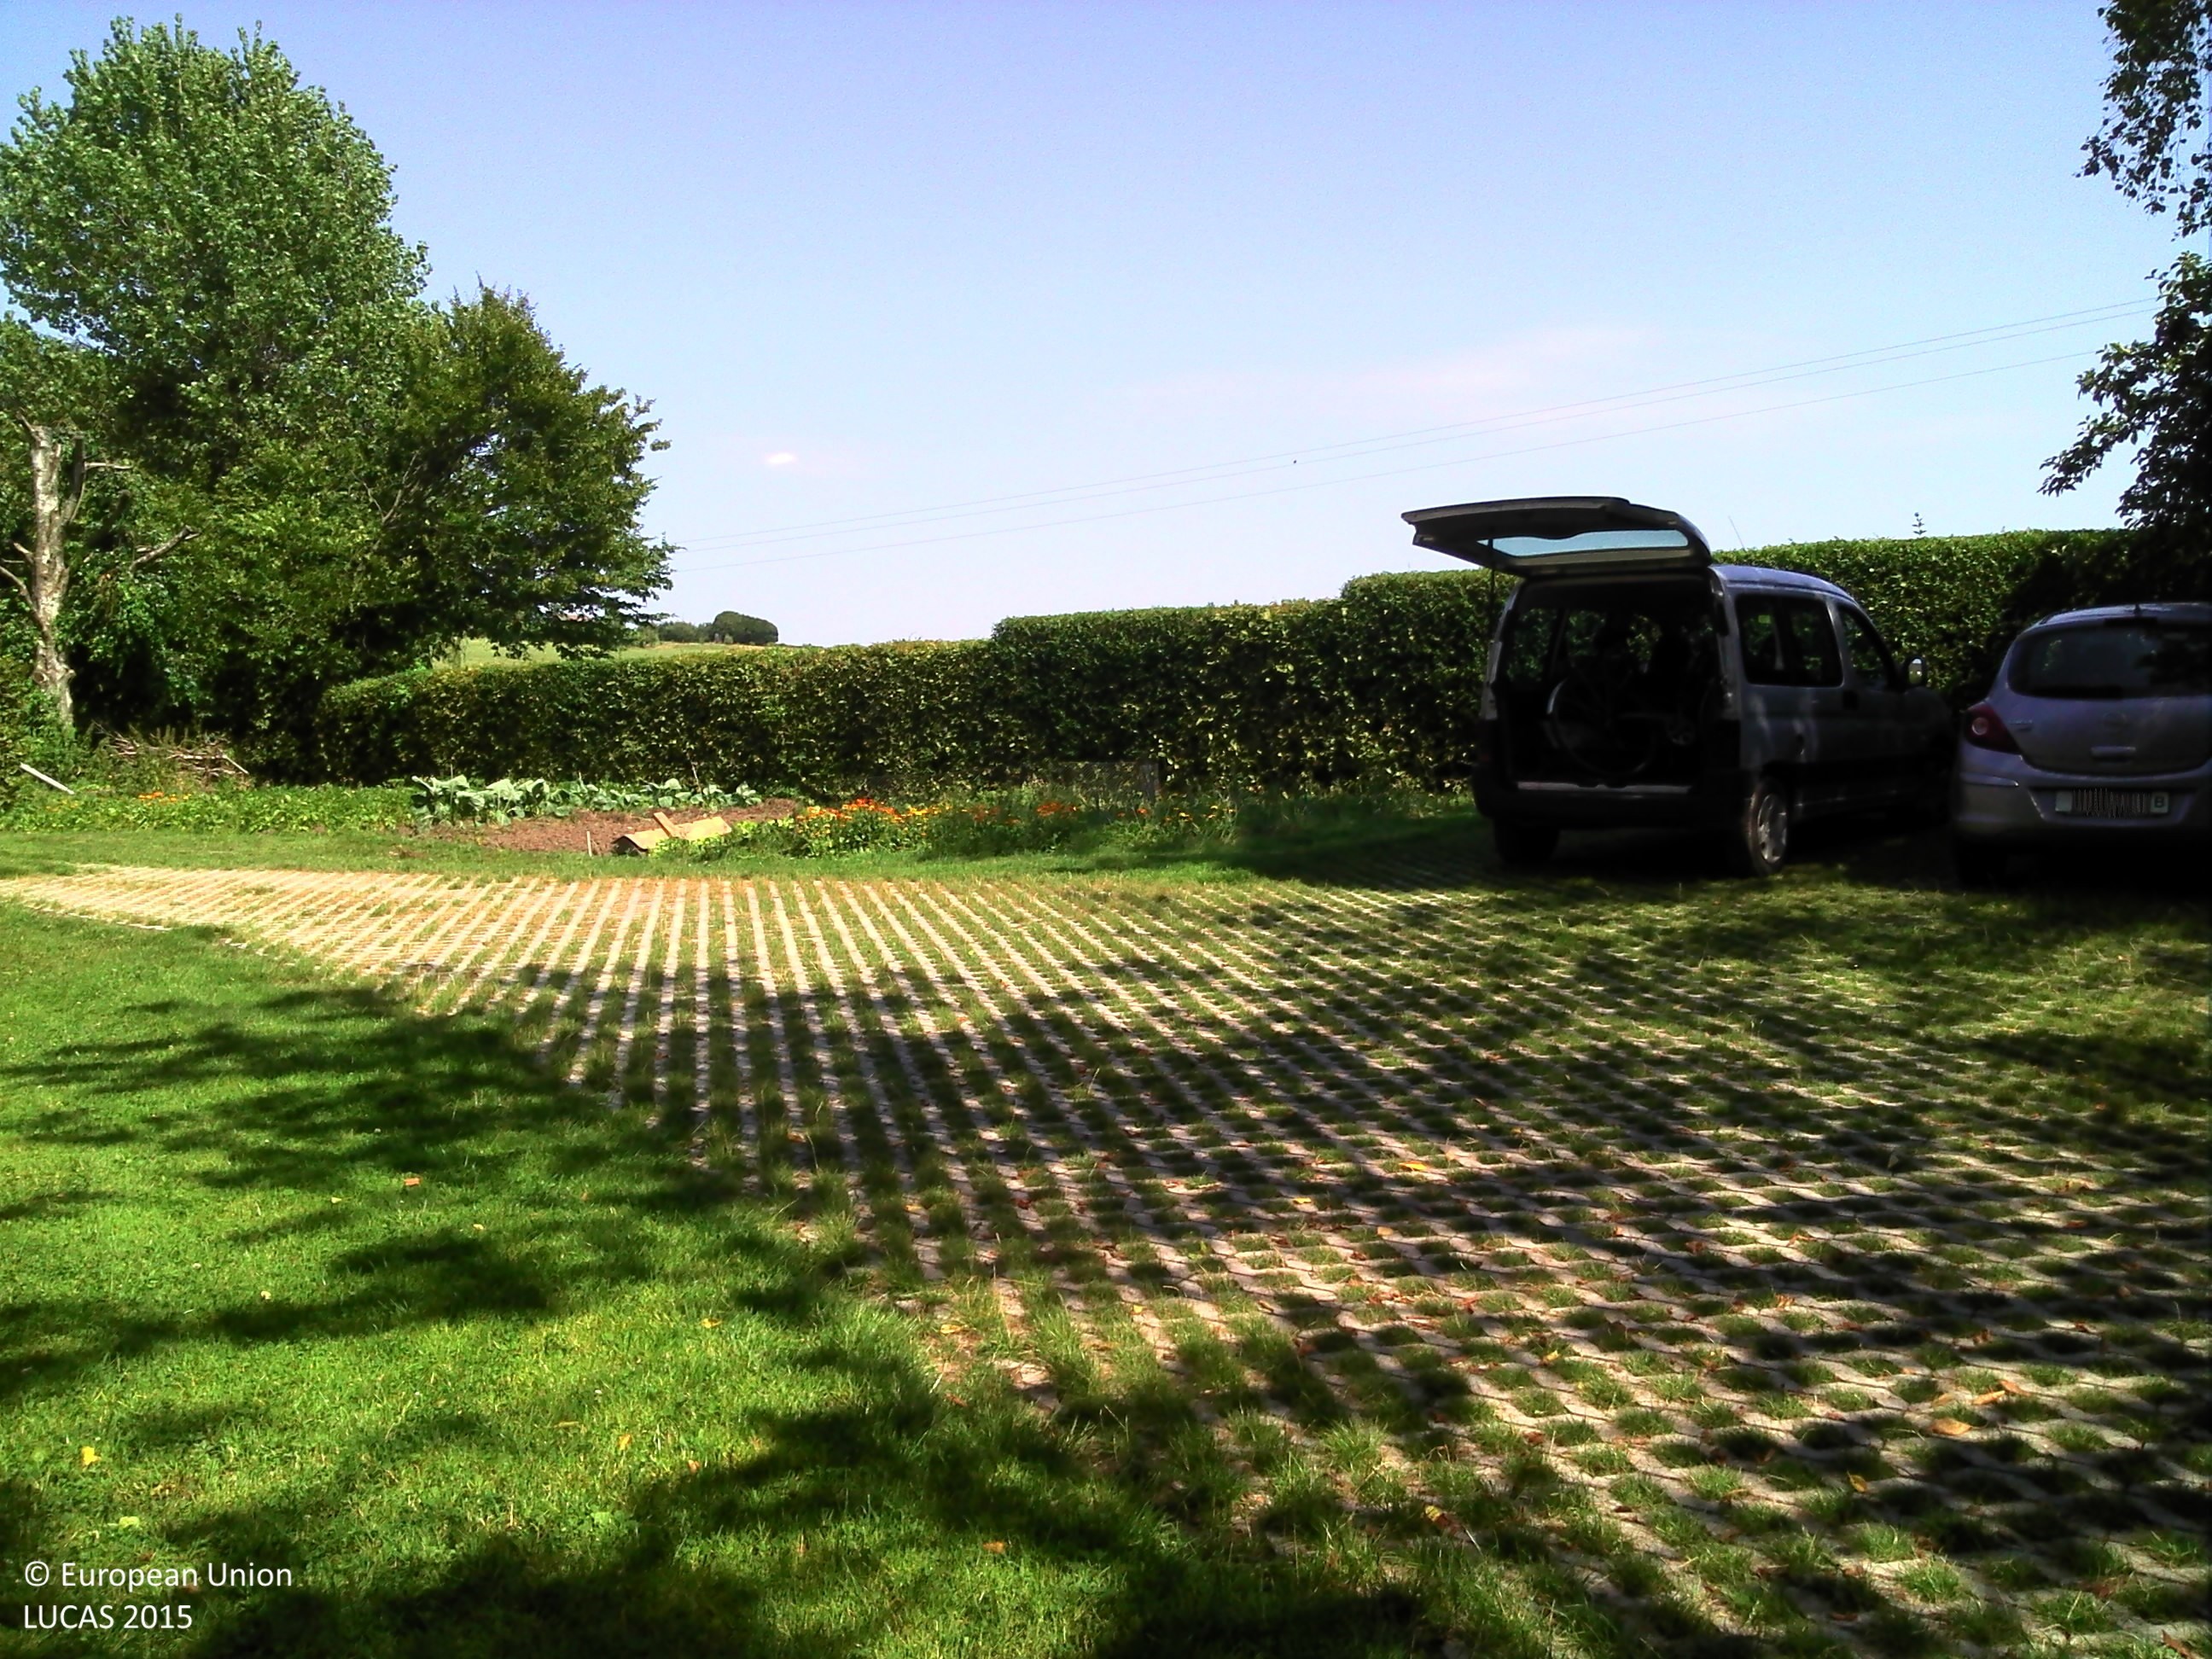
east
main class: Grassland
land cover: Grassland with sparse tree/shrub cover
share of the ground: > 75 %
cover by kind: herbaceous plants 95 %, broadleaved forest trees 5 %
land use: Residential
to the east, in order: Grassland with sparse tree/shrub cover; Artificial constructions in urban areas; Other fibre and oleaginous crops; Grass margins; Fences; Grassland without tree/shrub cover
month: July
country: BE
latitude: 50.6428
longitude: 5.6855
